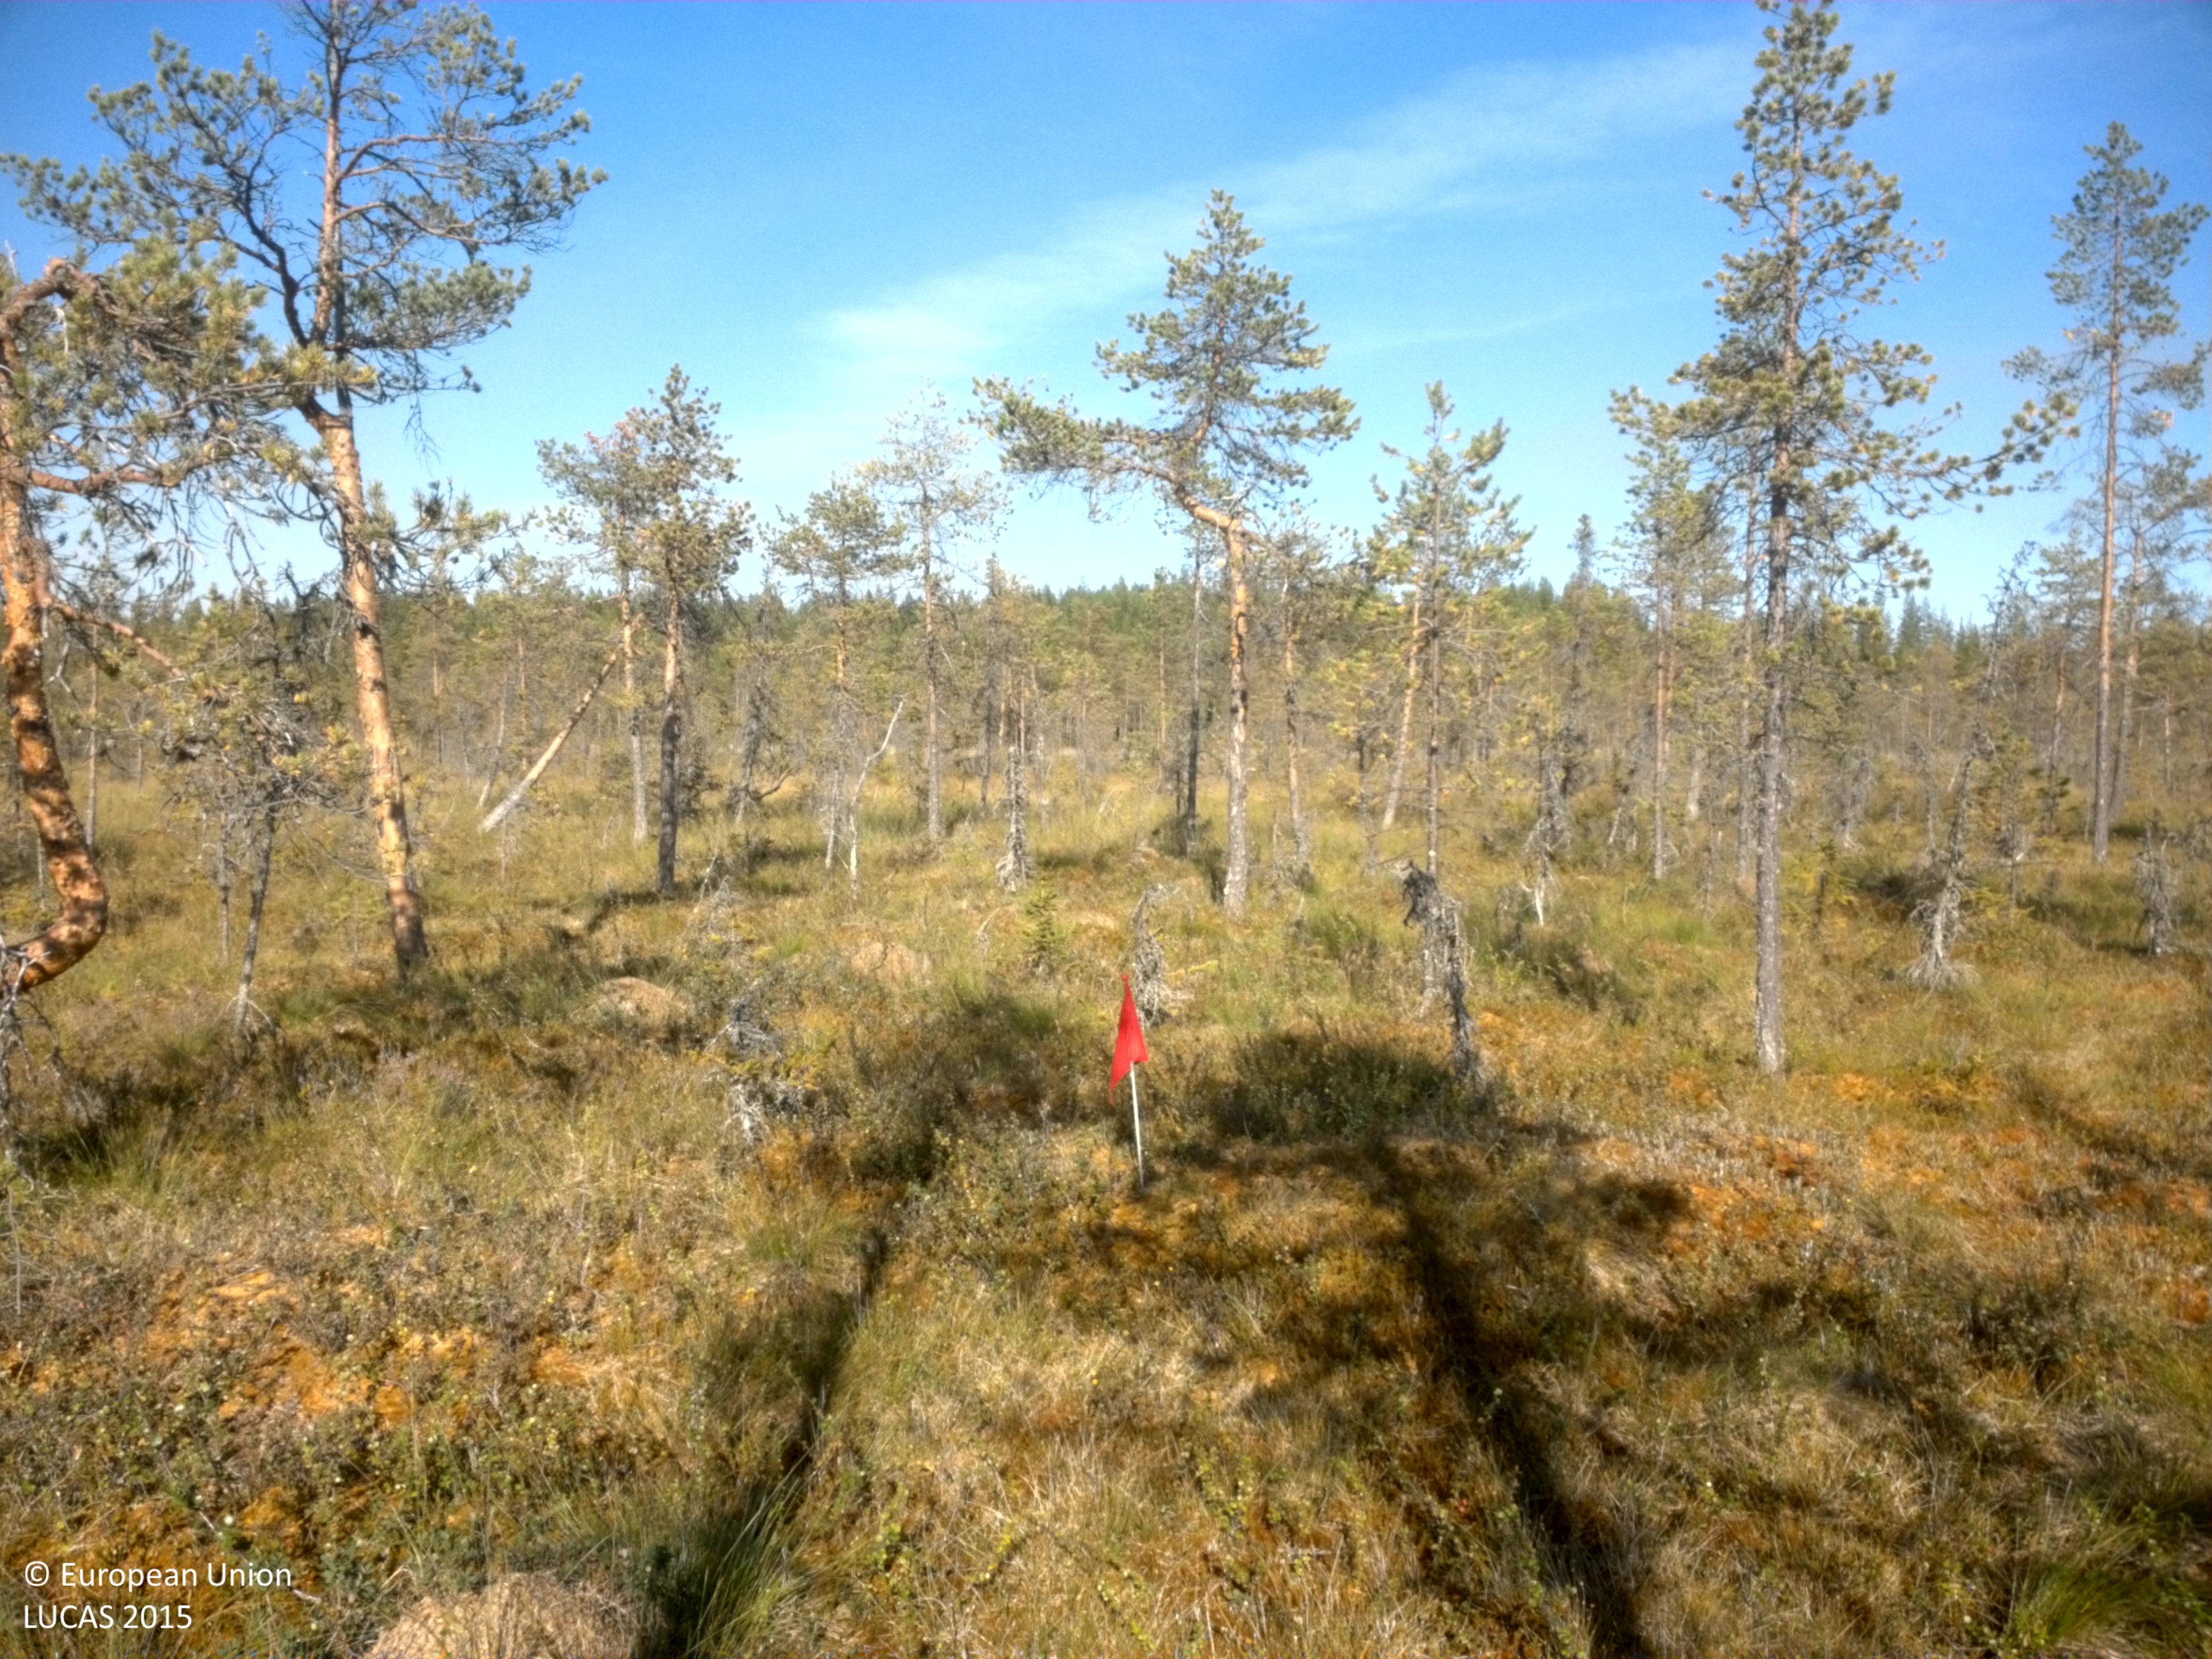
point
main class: Woodland
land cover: Pine dominated coniferous woodland
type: boreal forest
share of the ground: 25 - 50 %
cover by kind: coniferous forest trees 35 %, herbaceous plants 25 %, shrubs 20 %, lichens and mosses 20 %
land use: Semi-natural and natural areas not in use
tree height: > 5 m
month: August
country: SE
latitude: 64.5183
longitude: 18.4469
